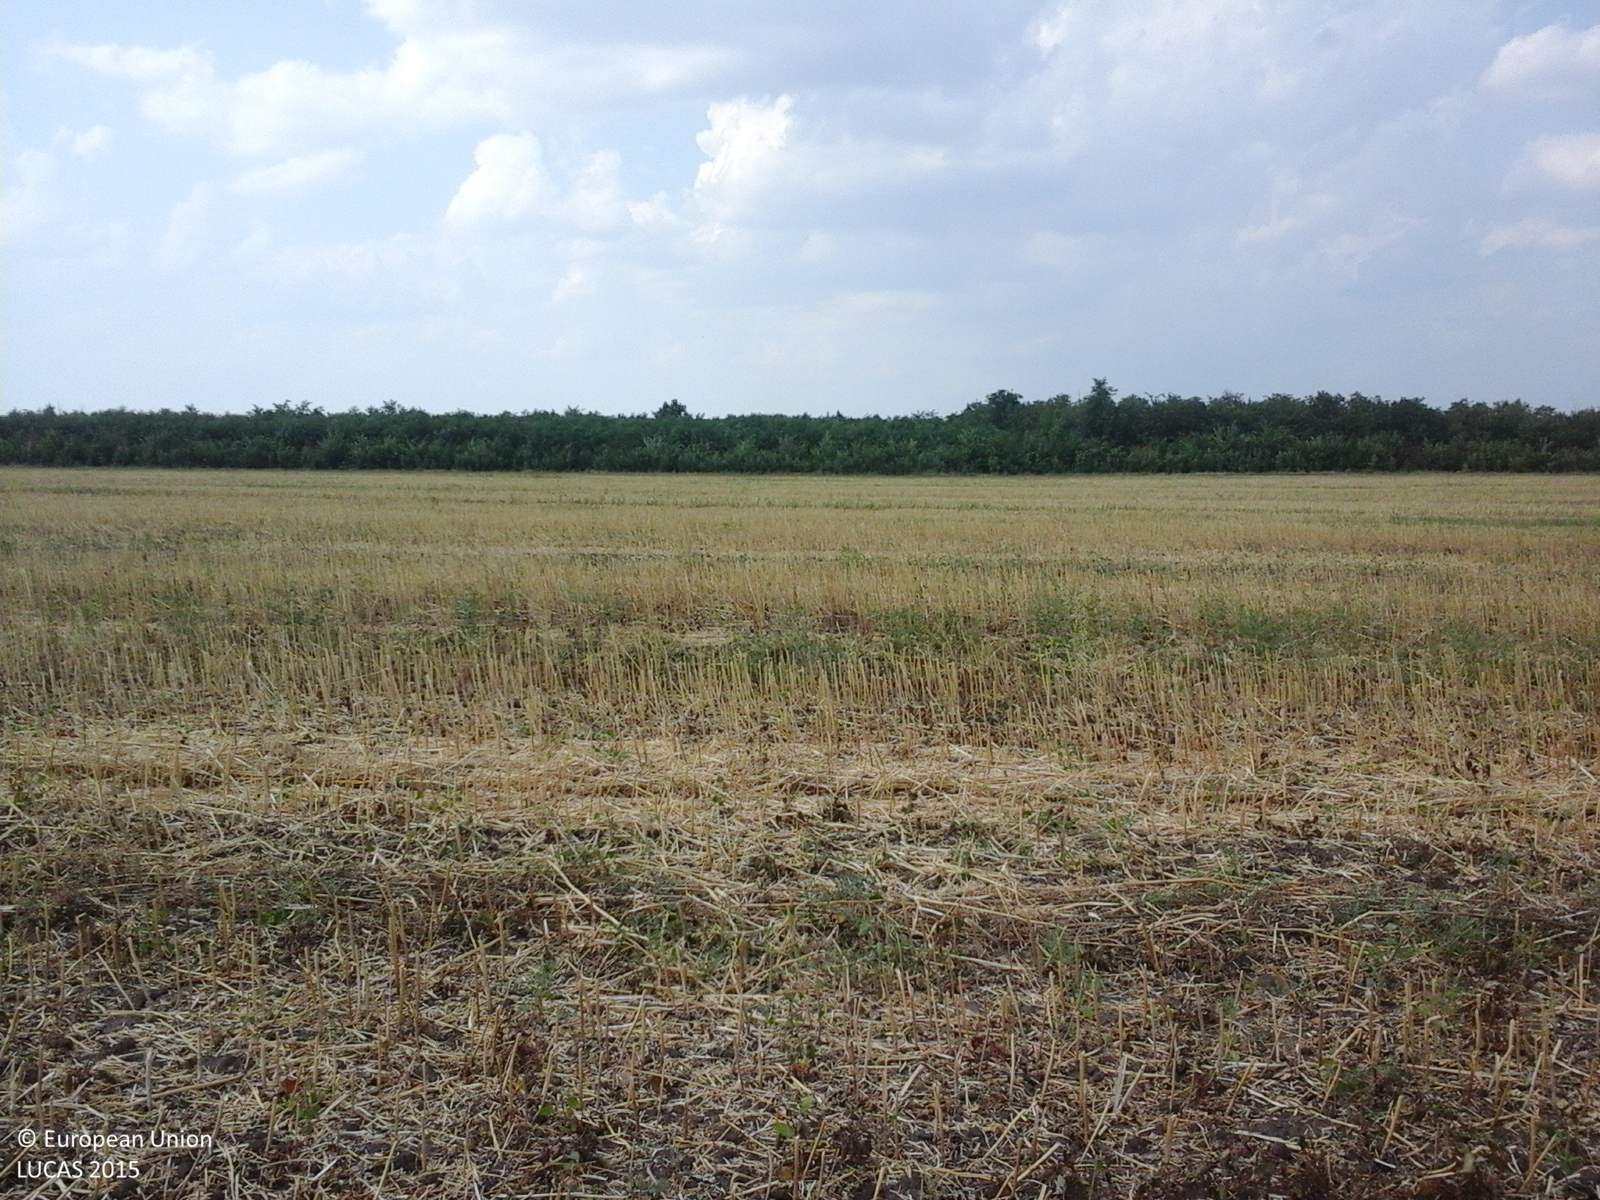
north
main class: Cropland
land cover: Rape and turnip rape
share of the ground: 10 - 25 %
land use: Agriculture (excluding fallow land and kitchen gardens)
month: July
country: RO
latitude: 45.7827
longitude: 27.9057
